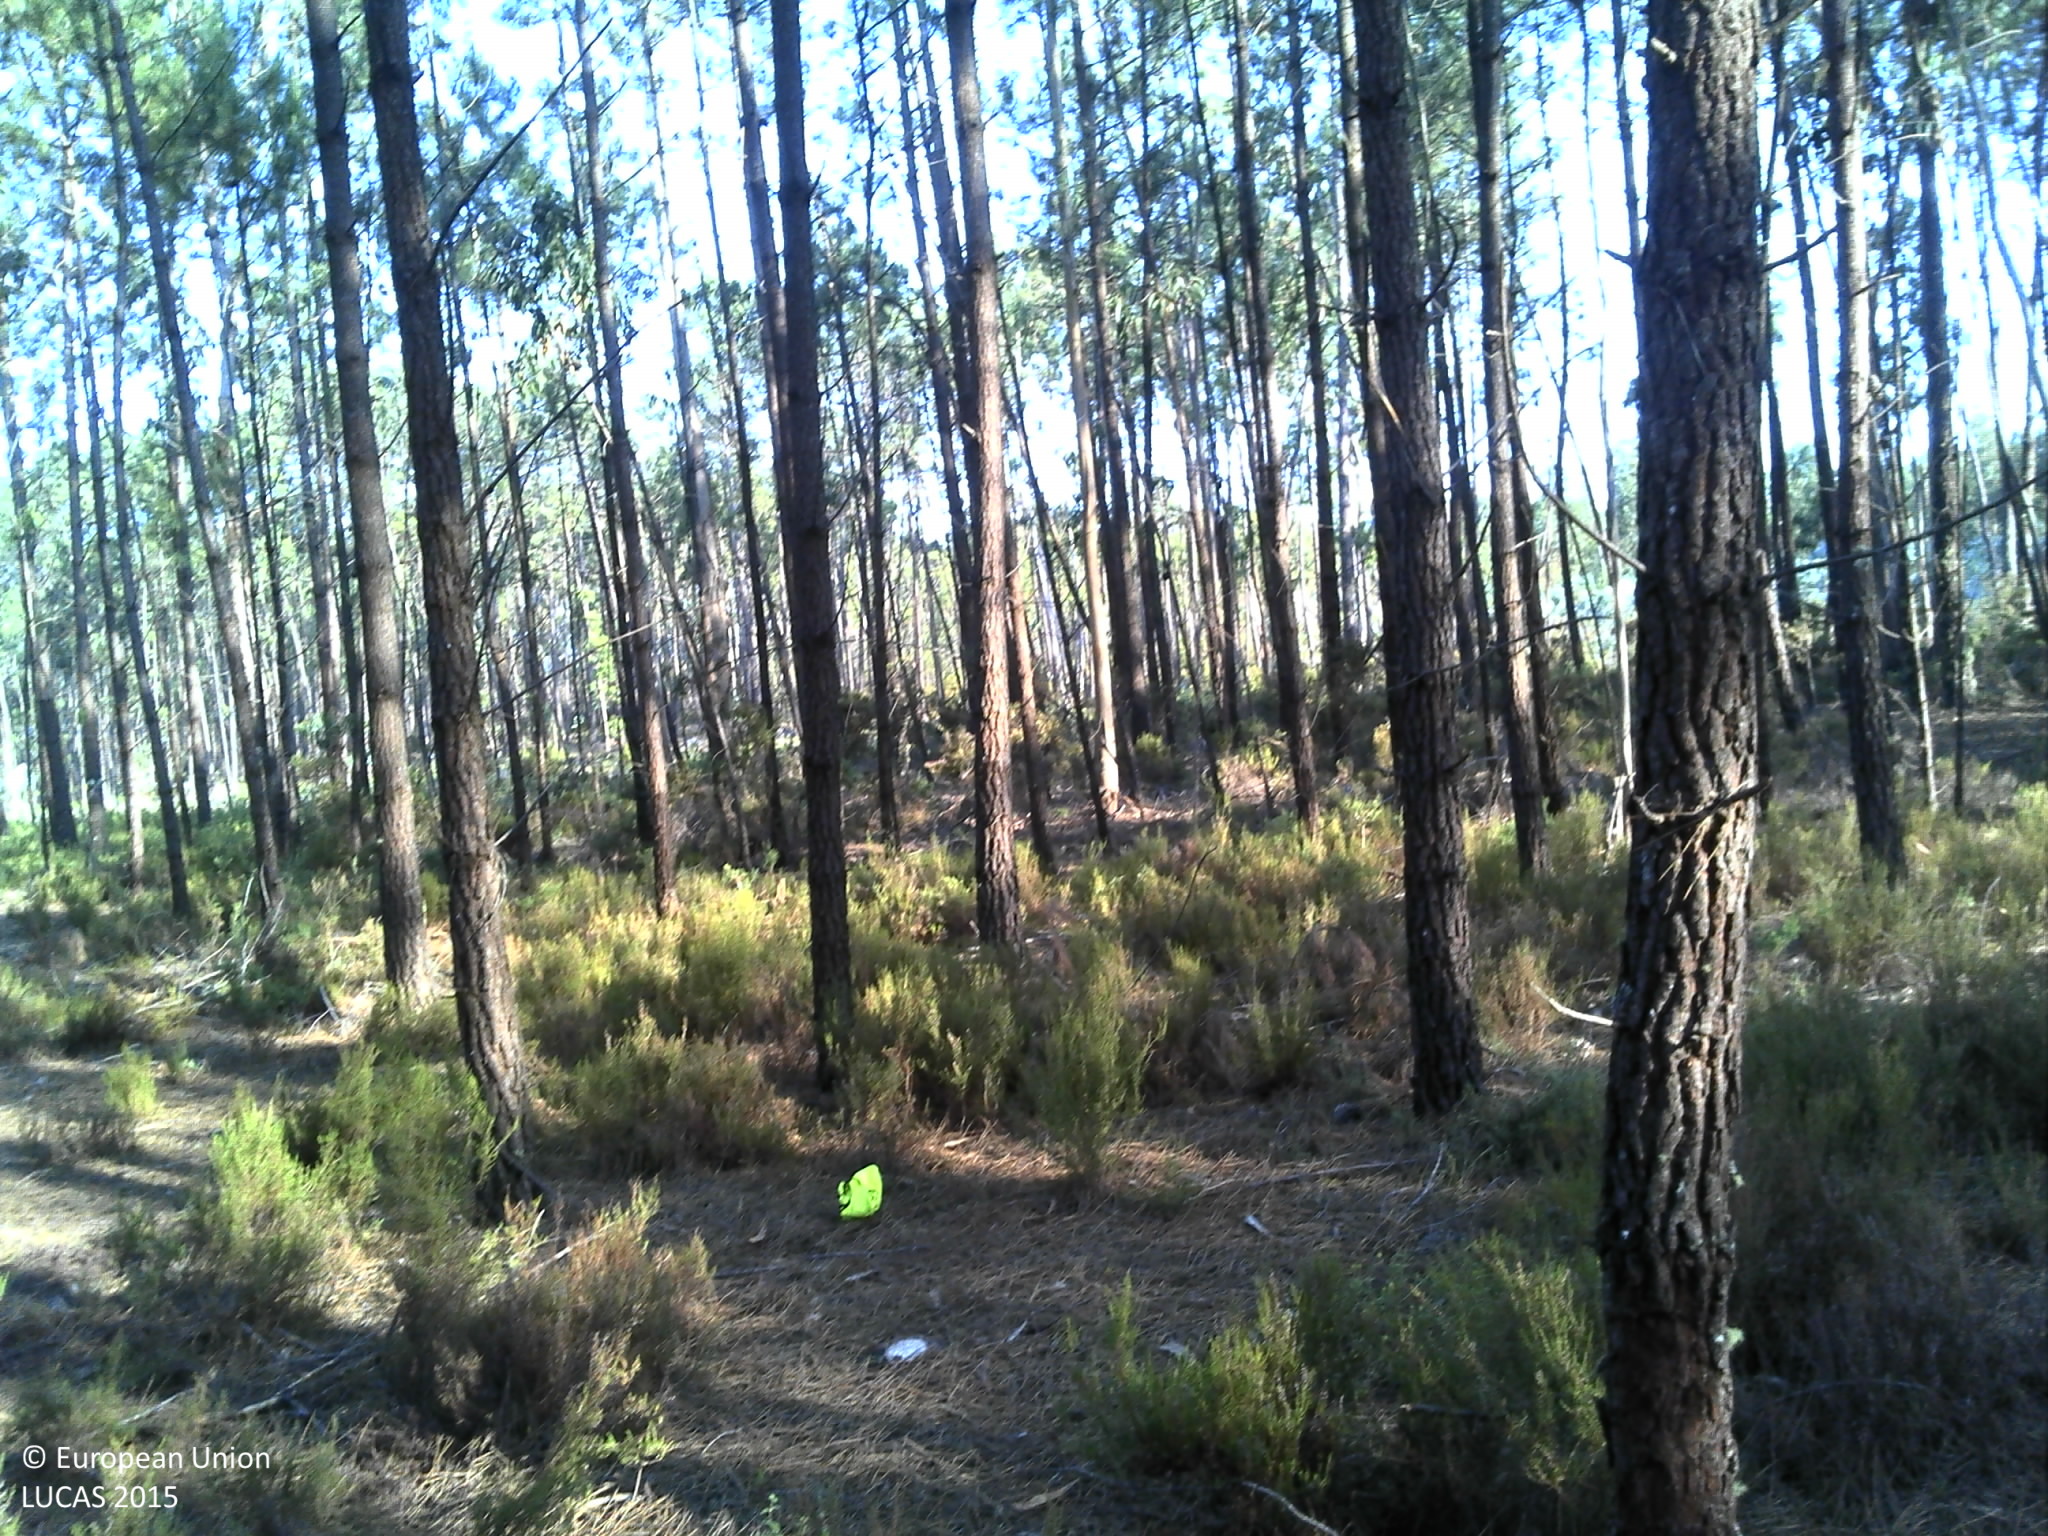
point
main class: Woodland
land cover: Pine dominated coniferous woodland
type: coniferous forest of the mediterranean region
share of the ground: > 75 %
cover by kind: coniferous forest trees 85 %, unconsolidated bare surface 10 %, shrubs 5 %
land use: Forestry
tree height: > 5 m
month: June
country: PT
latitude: 39.7818
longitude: -8.8996
